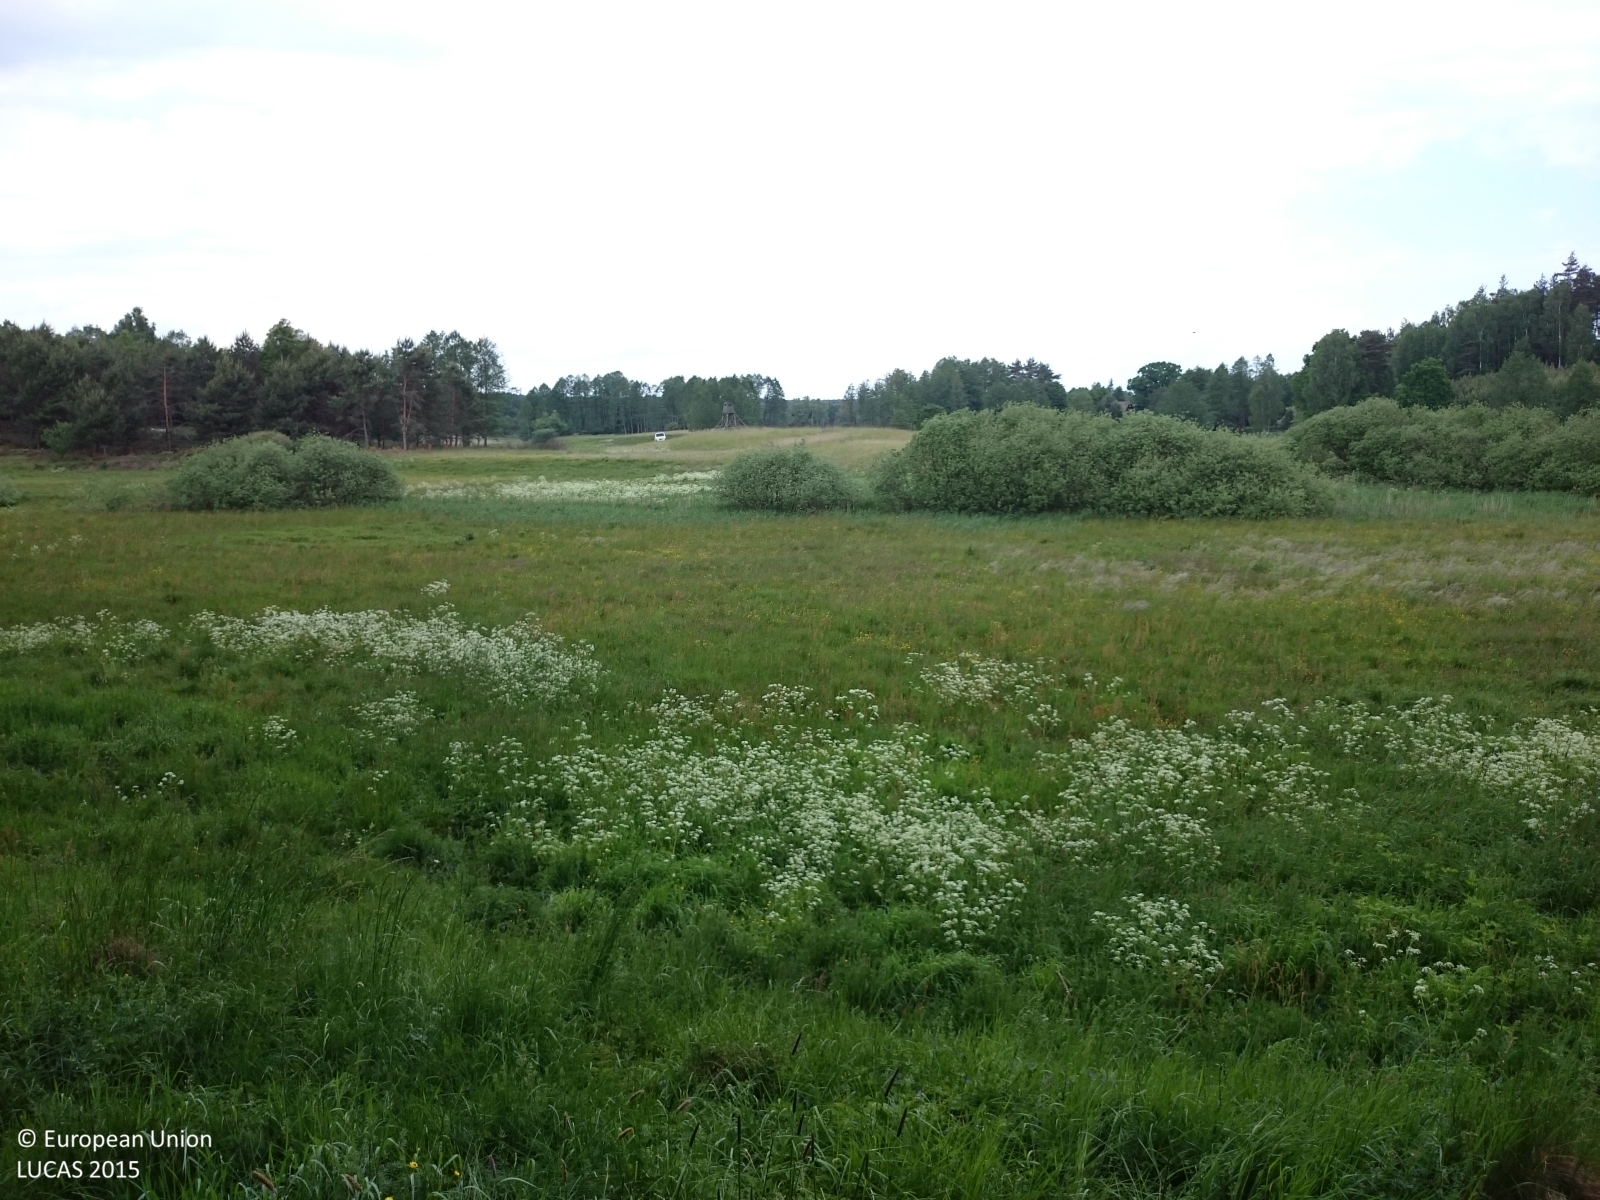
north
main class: Grassland
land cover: Grassland with sparse tree/shrub cover
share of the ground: > 75 %
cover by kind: herbaceous plants 95 %, broadleaved forest trees 5 %
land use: Semi-natural and natural areas not in use
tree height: < 5 m
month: March
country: PL
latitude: 53.0240
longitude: 16.2530
